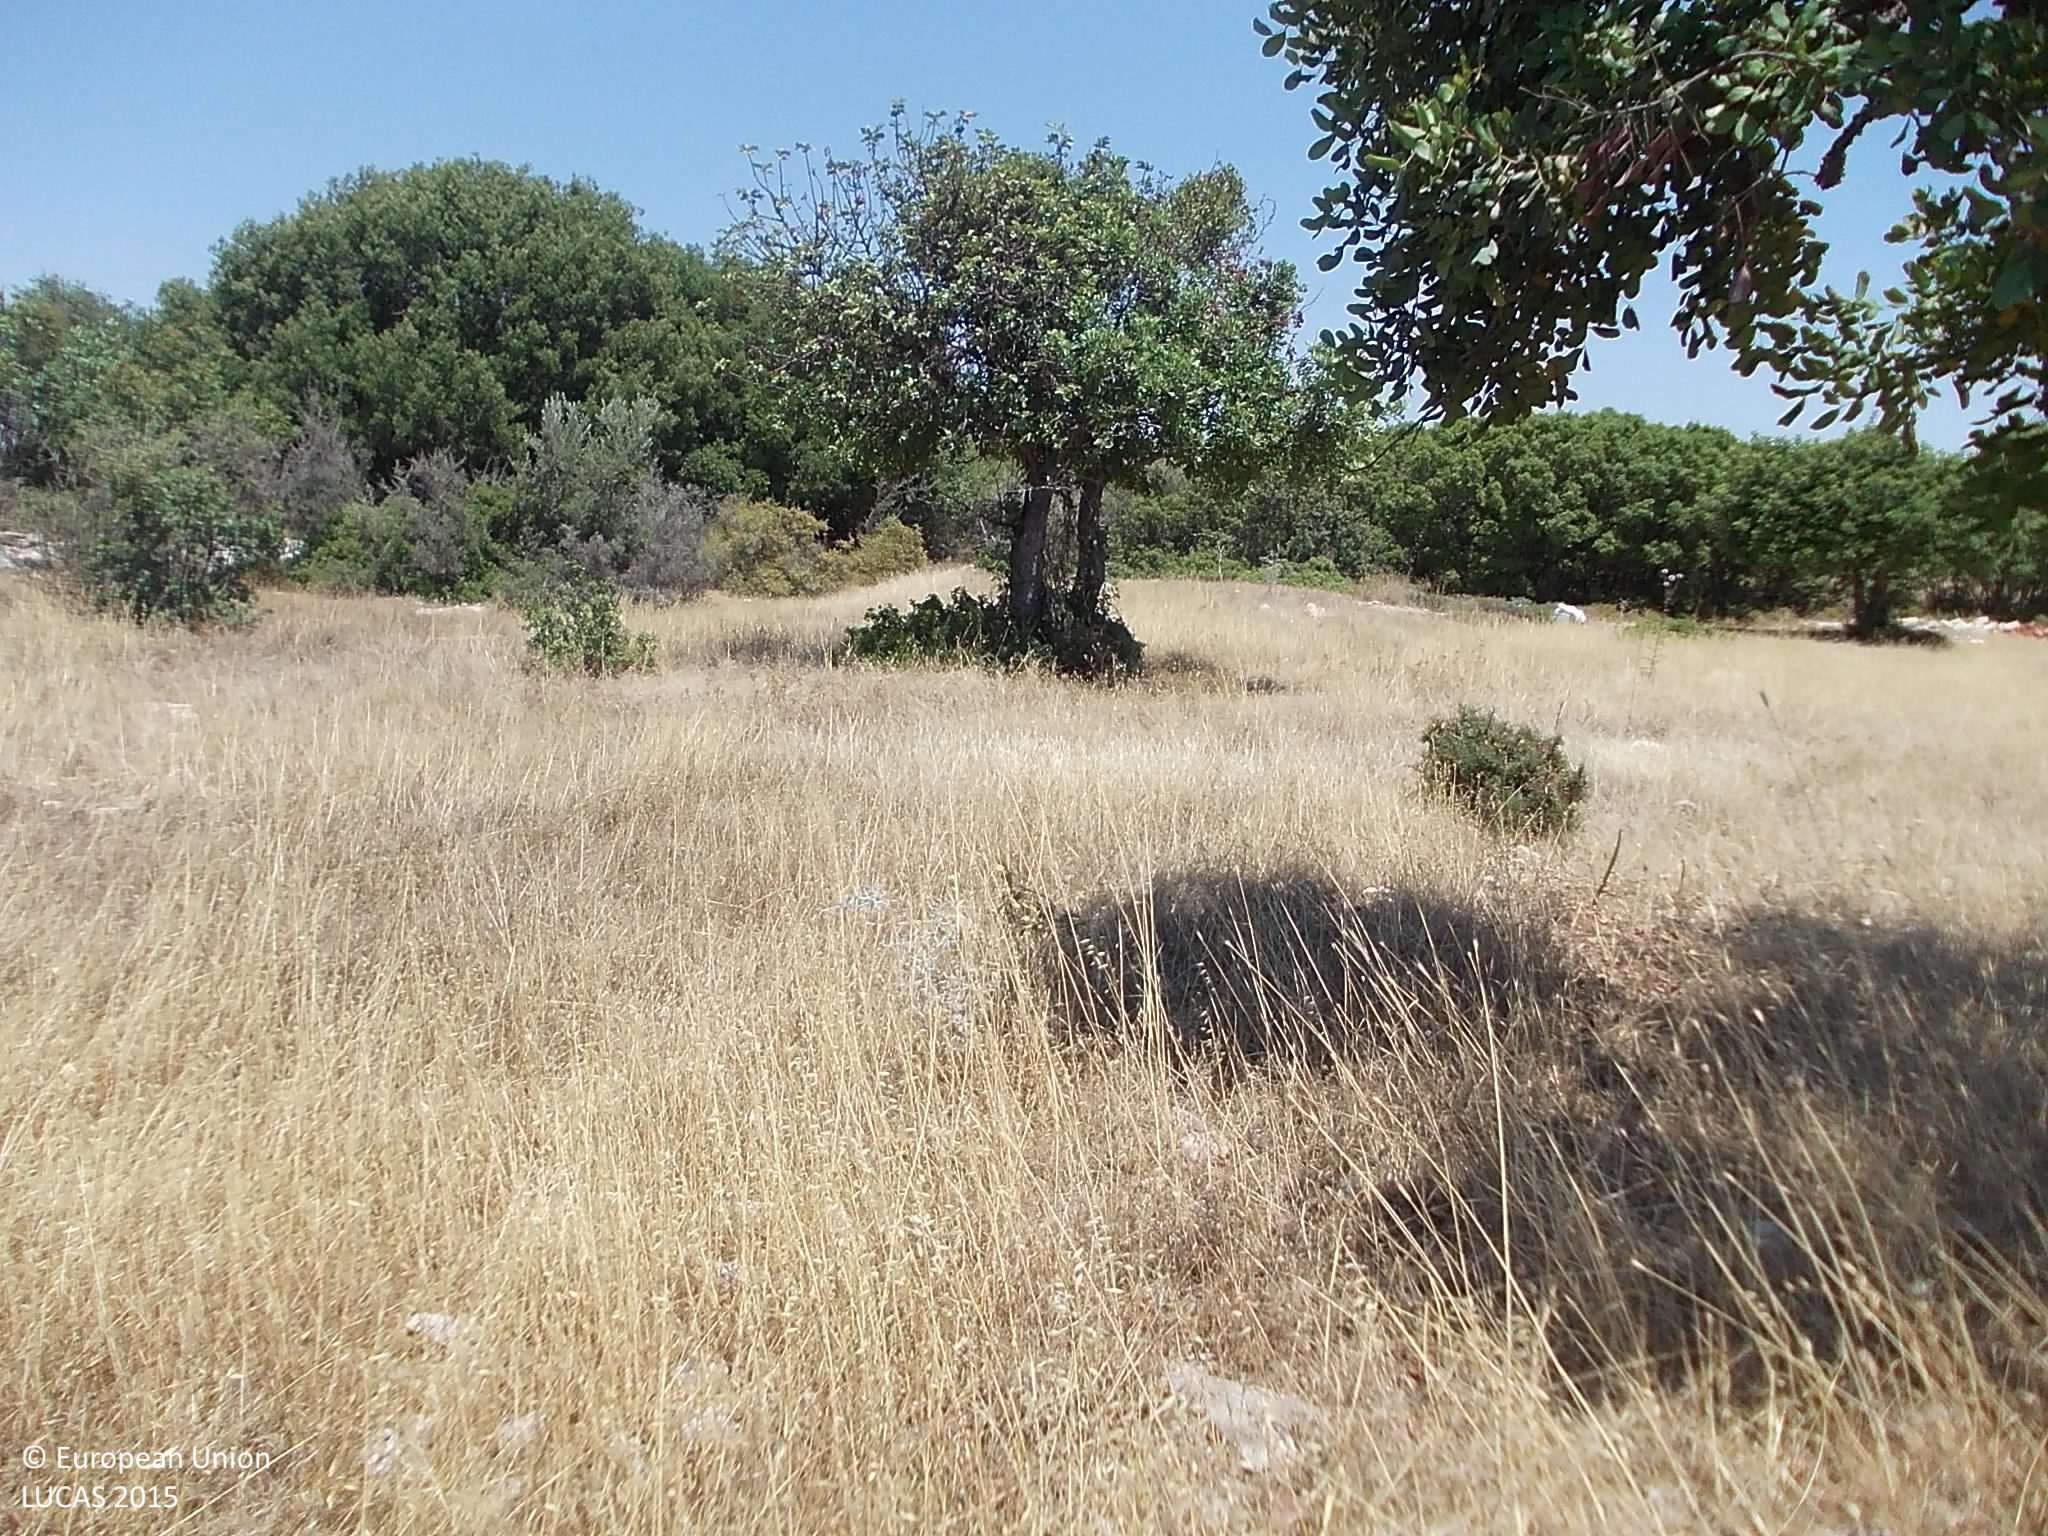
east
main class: Grassland
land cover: Grassland with sparse tree/shrub cover
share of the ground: > 75 %
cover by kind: herbaceous plants 90 %, broadleaved forest trees 5 %, shrubs 5 %
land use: Semi-natural and natural areas not in use
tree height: > 5 m
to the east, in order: Grassland with sparse tree/shrub cover; Nuts trees; Electric lines; Shrubland with sparse tree cover; Nuts trees; Dry stone walls; Fences; Grassland without tree/shrub cover; Fences; Abandoned hedges; Paved roads, cycling and walking lanes; Grassland without tree/shrub cover; Single bushes/trees; Tracks; Other bare soil
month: July
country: CY
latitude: 34.7317
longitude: 32.7287
